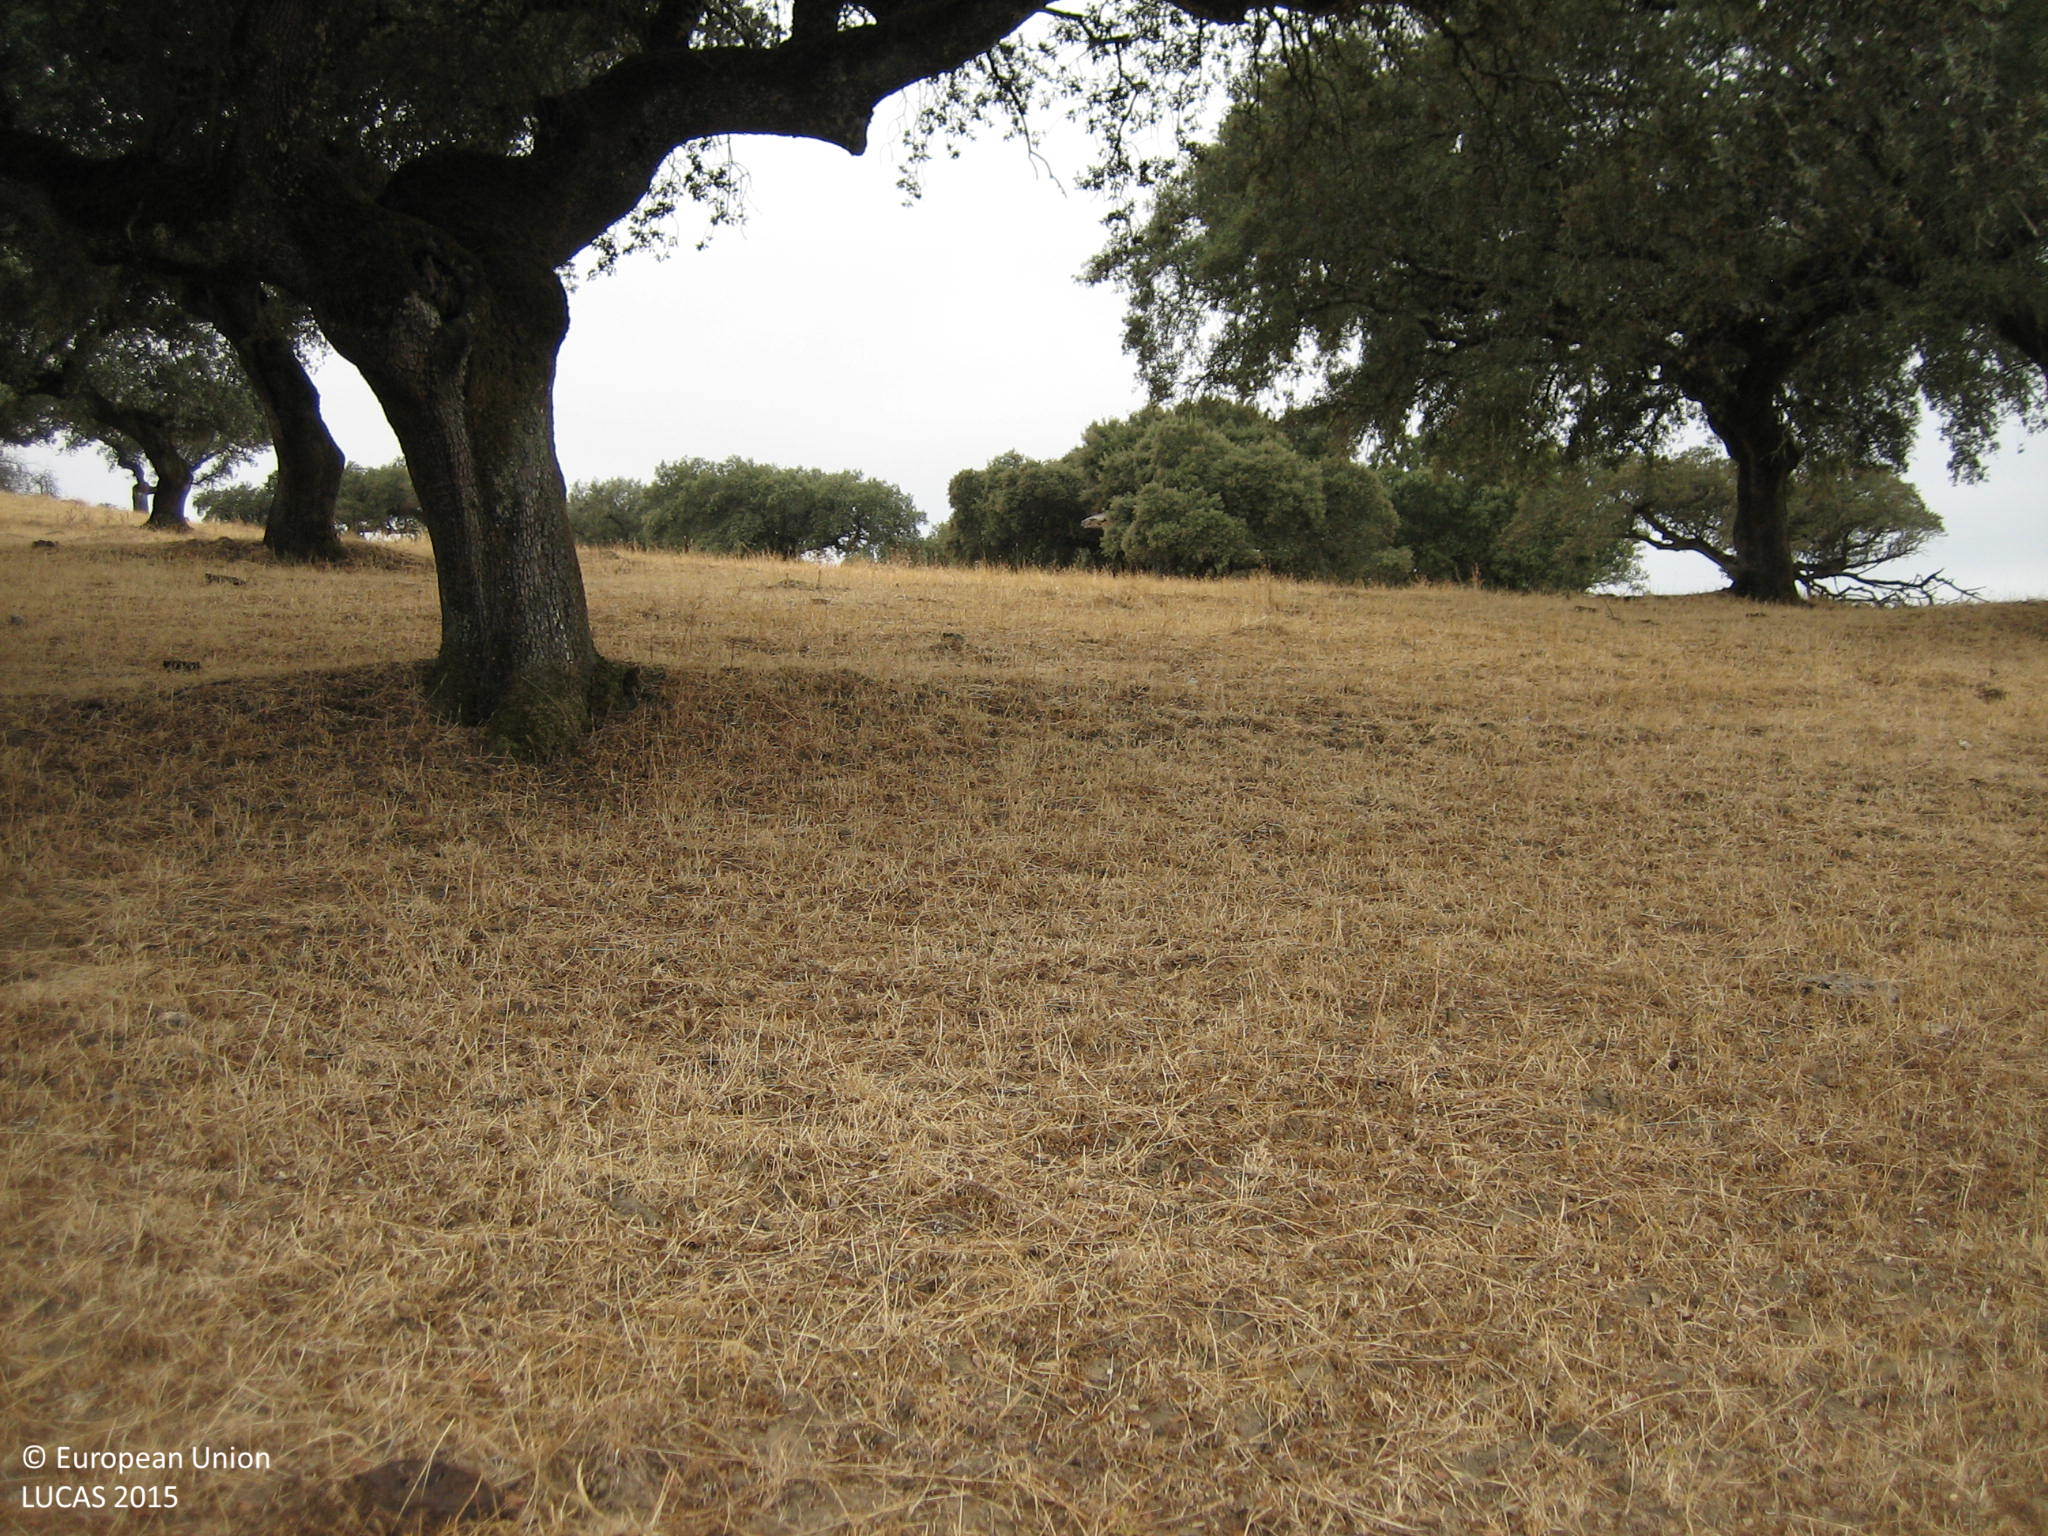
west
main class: Woodland
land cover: Broadleaved woodland
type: broadleaved evergreen forest
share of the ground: 25 - 50 %
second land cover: Grassland without tree/shrub cover
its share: > 75 %
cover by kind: herbaceous plants 60 %, broadleaved forest trees 40 %
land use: Forestry
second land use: Agriculture (excluding fallow land and kitchen gardens)
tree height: > 5 m
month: September
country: ES
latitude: 38.3033
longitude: -6.8319
